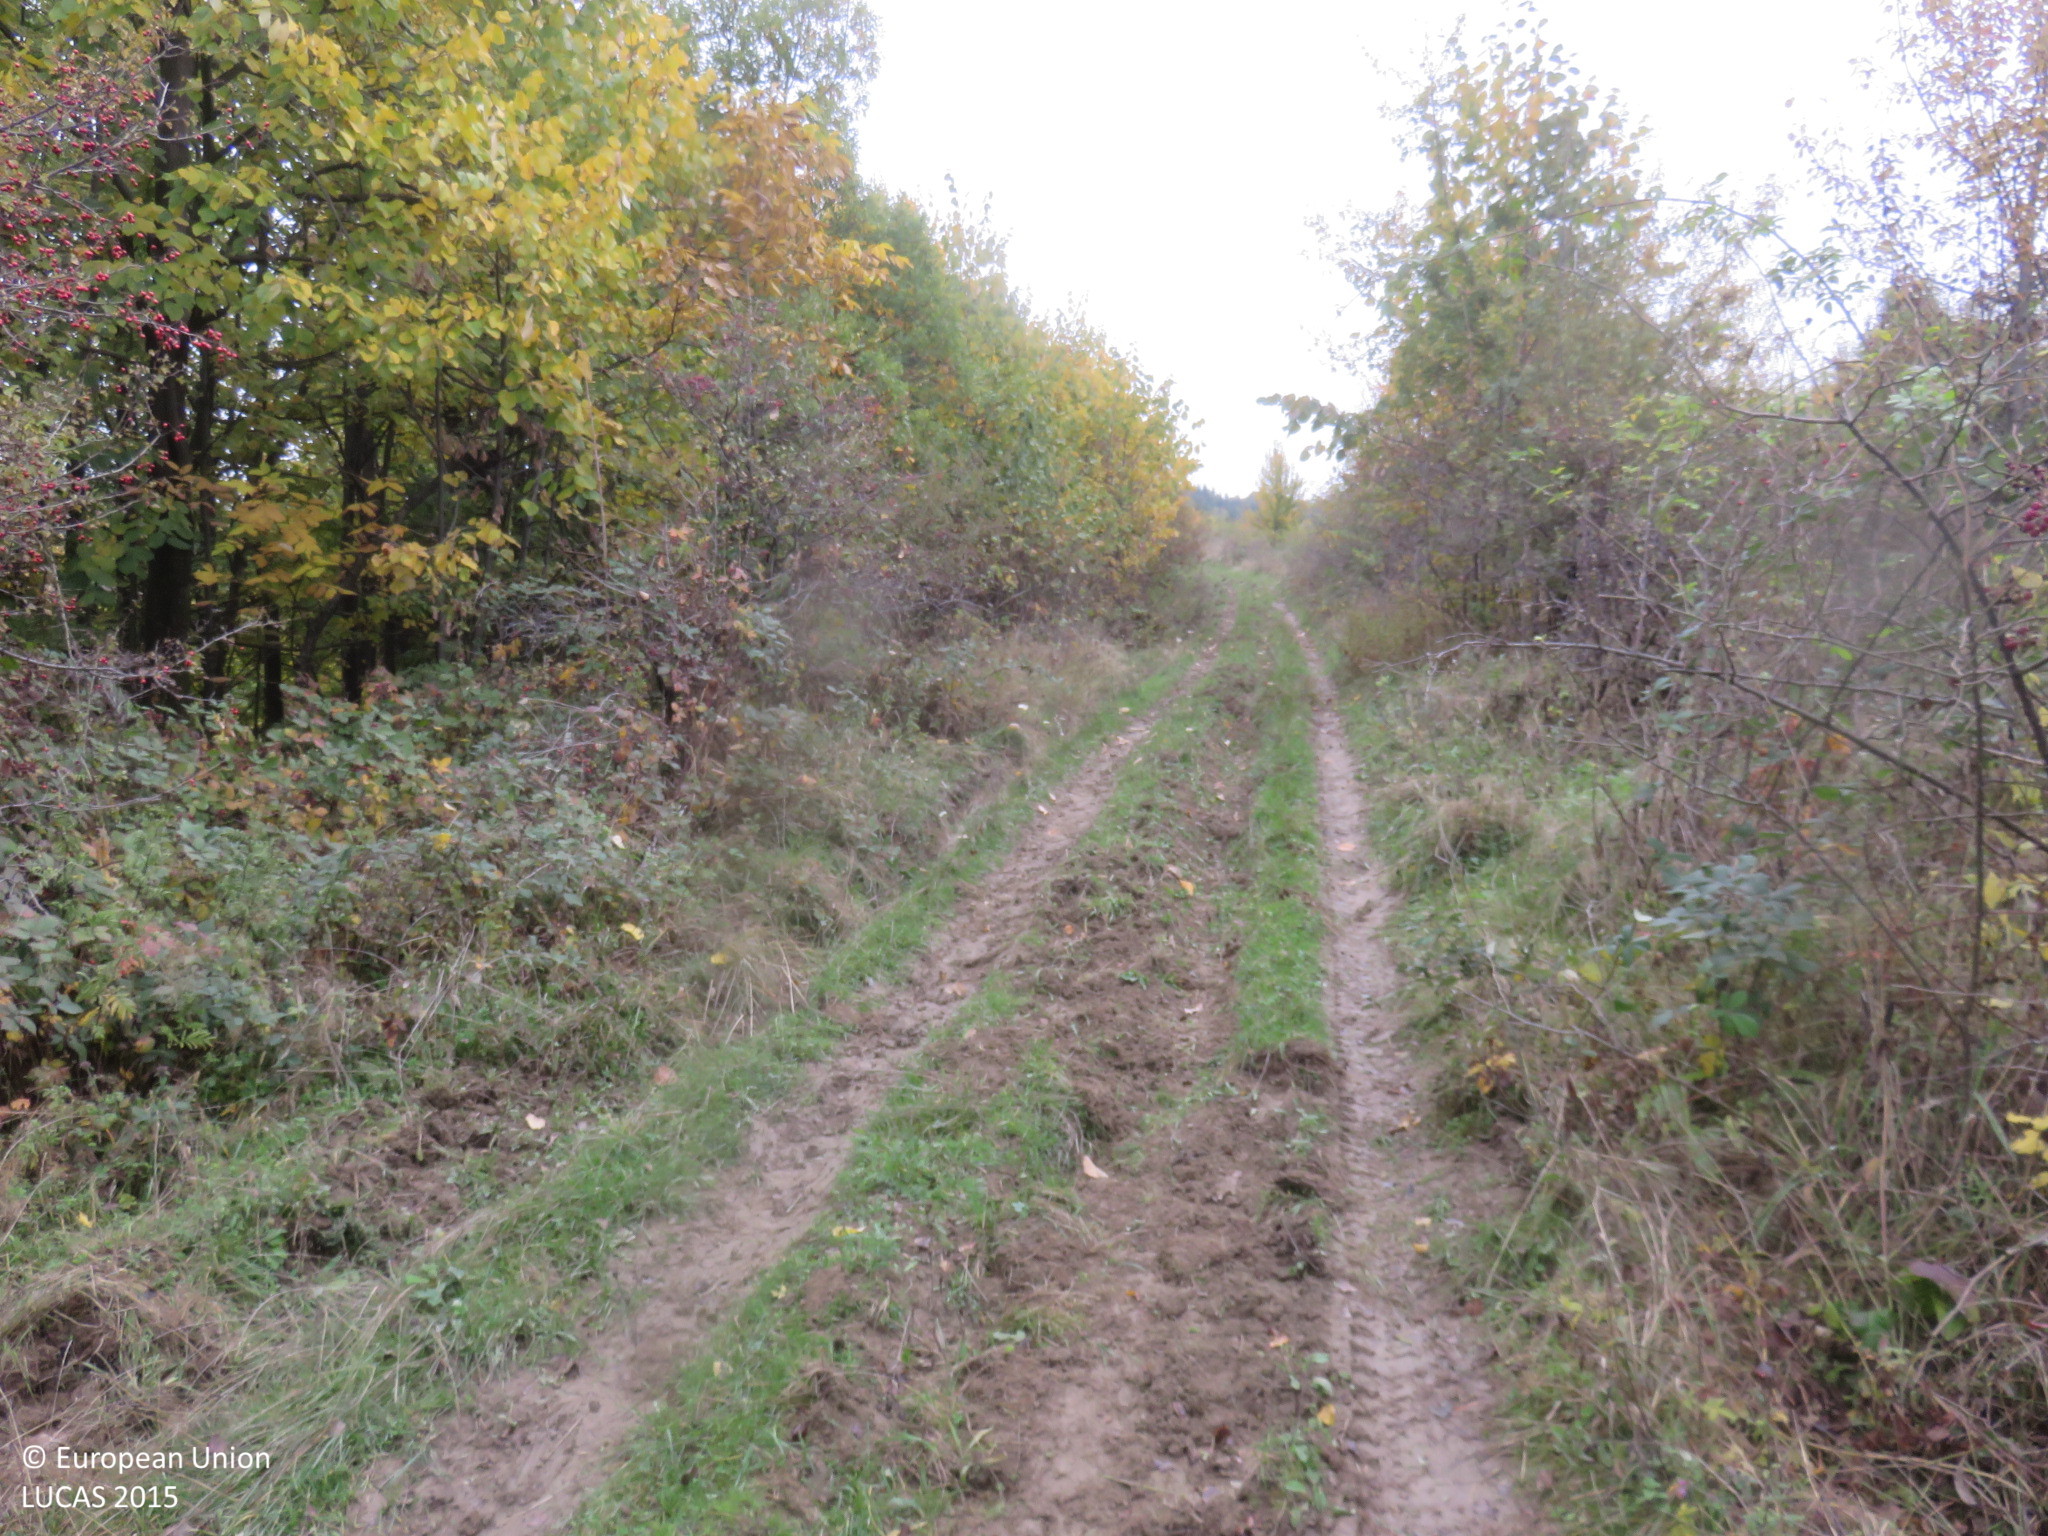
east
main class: Woodland
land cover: Pine dominated mixed woodland
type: hemiboreal forest and nemoral coniferous forest and mixed broadleaved-coniferous forest
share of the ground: > 75 %
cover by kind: coniferous forest trees 75 %, broadleaved forest trees 25 %
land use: Forestry
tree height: > 5 m
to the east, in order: Pine dominated mixed woodland; Tracks; Other mixed woodland
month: October
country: BG
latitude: 42.8345
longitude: 25.1015
